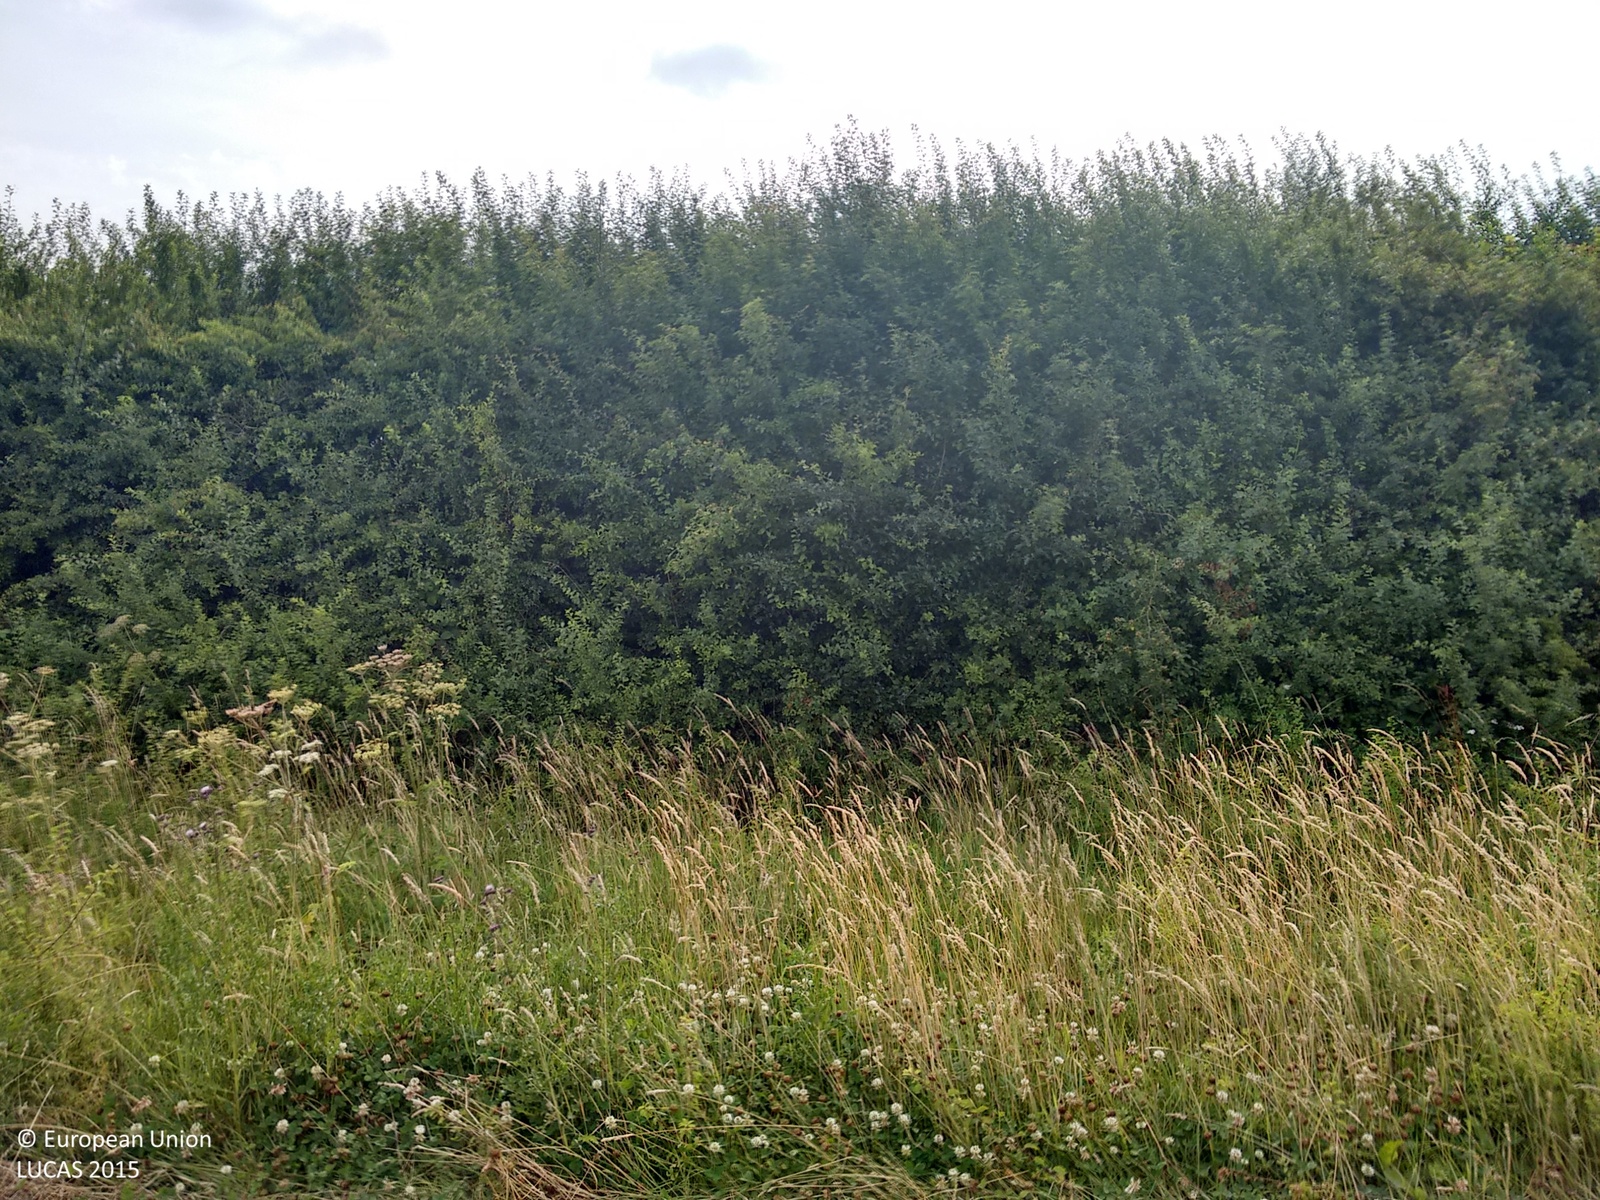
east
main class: Cropland
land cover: Oats
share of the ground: > 75 %
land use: Agriculture (excluding fallow land and kitchen gardens)
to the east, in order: Oats; Grassland without tree/shrub cover; Managed hedges; Grass margins; Common wheat; Tracks; Spontaneously vegetated surfaces; Grass margins; Managed hedges
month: July
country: GB
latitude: 53.1077
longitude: -0.9023
